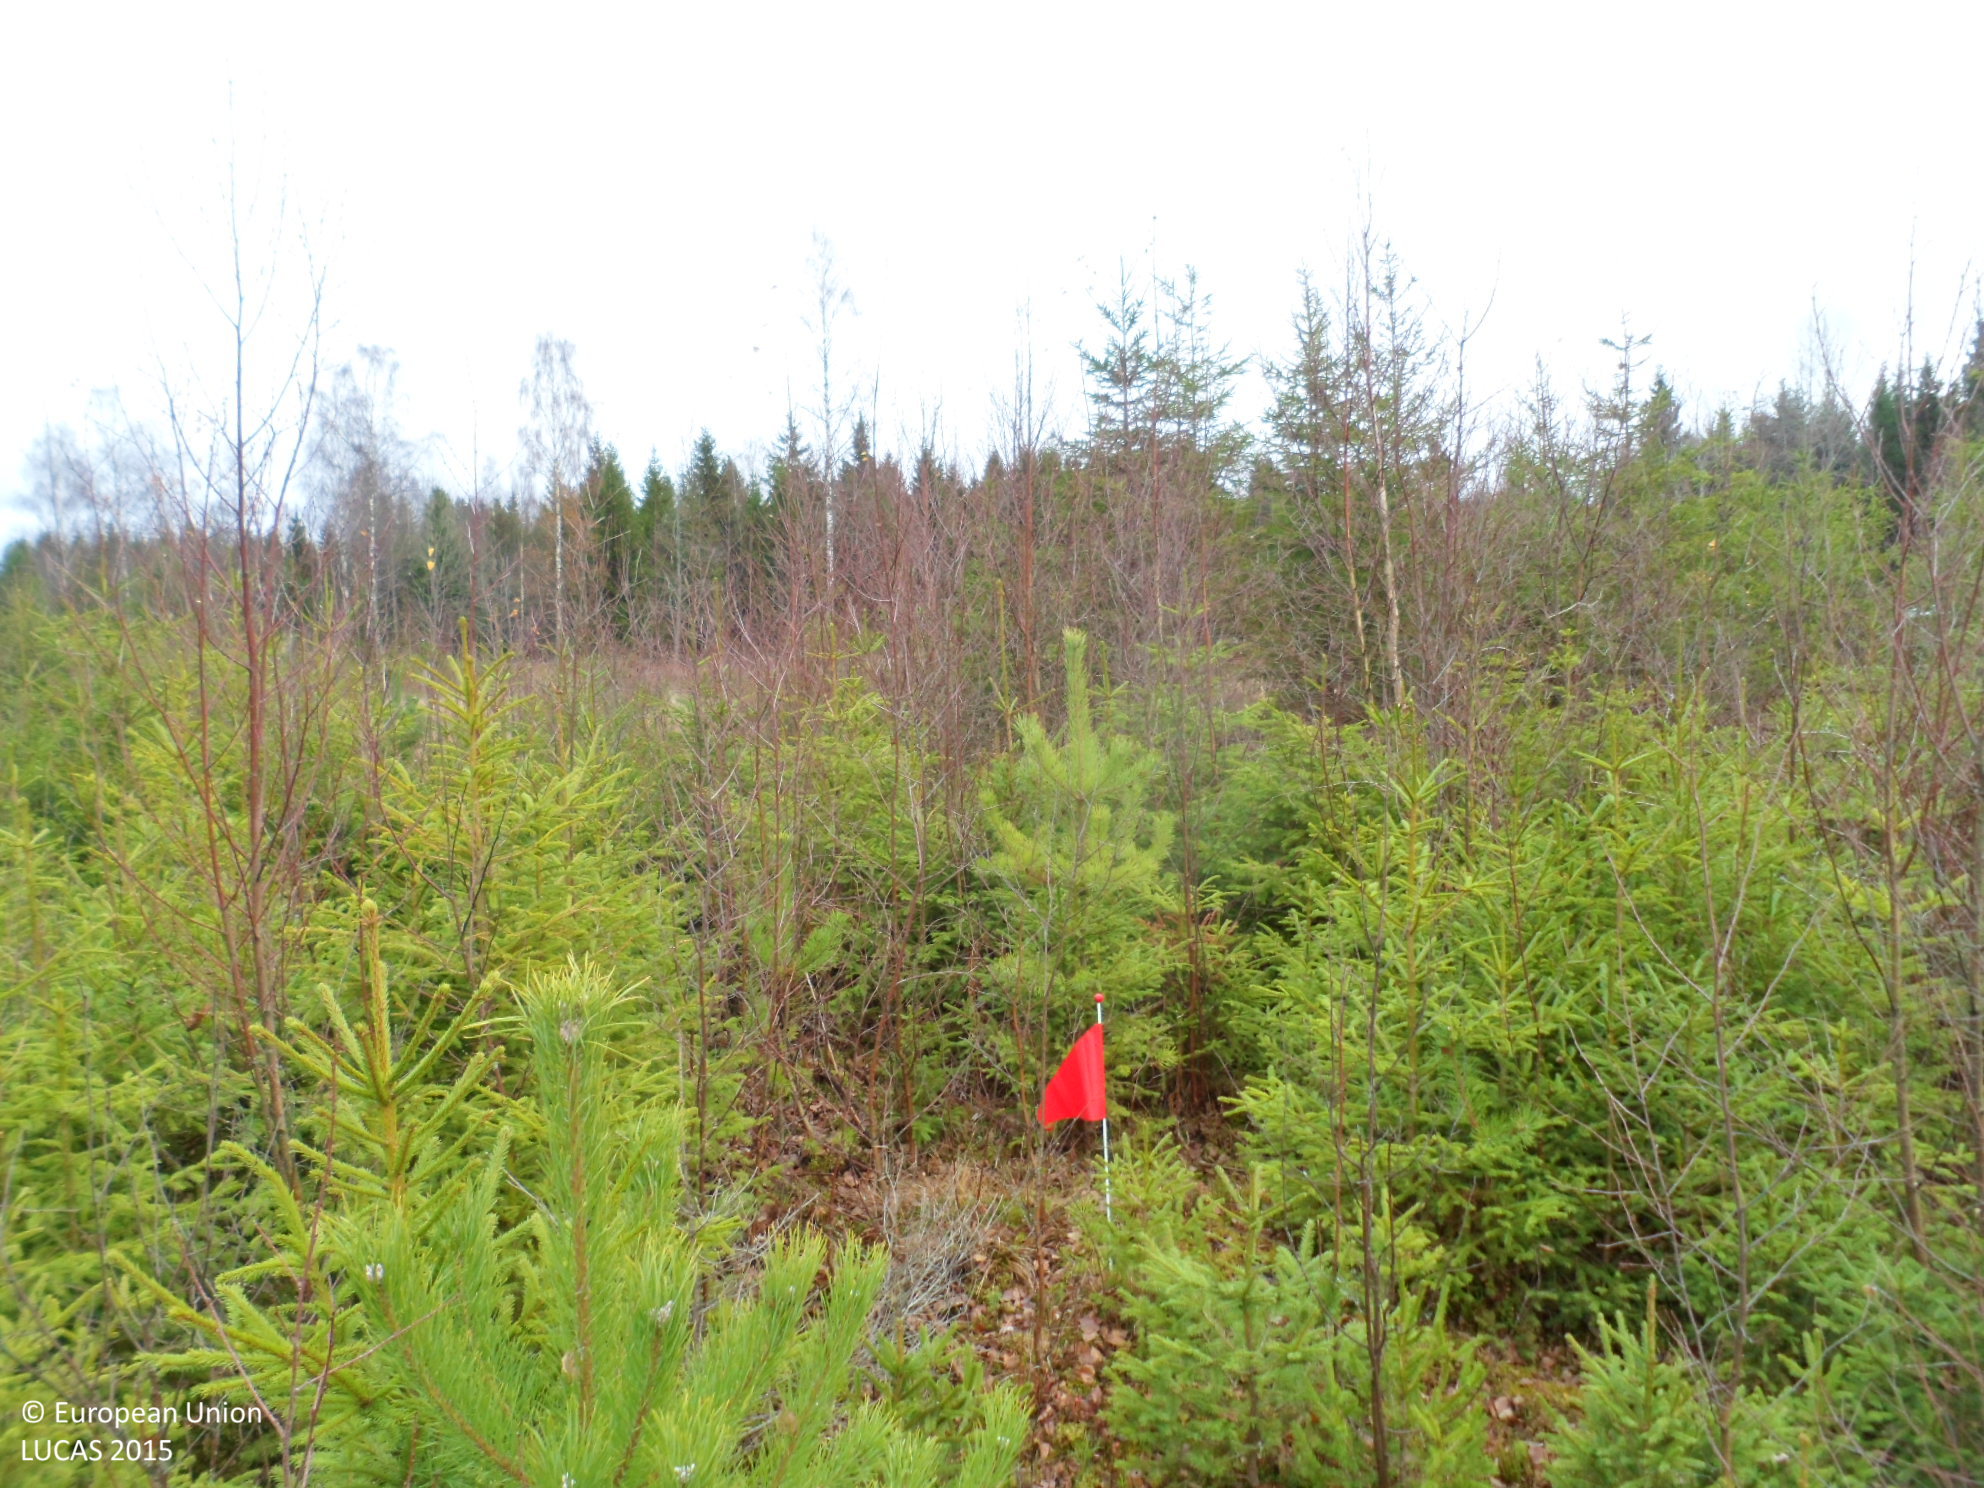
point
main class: Woodland
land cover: Spruce dominated mixed woodland
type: boreal forest
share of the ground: 50 - 75 %
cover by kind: coniferous forest trees 50 %, broadleaved forest trees 25 %, shrubs 10 %, lichens and mosses 10 %, herbaceous plants 5 %
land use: Forestry
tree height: < 5 m
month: November
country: SE
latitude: 56.7895
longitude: 15.9418
